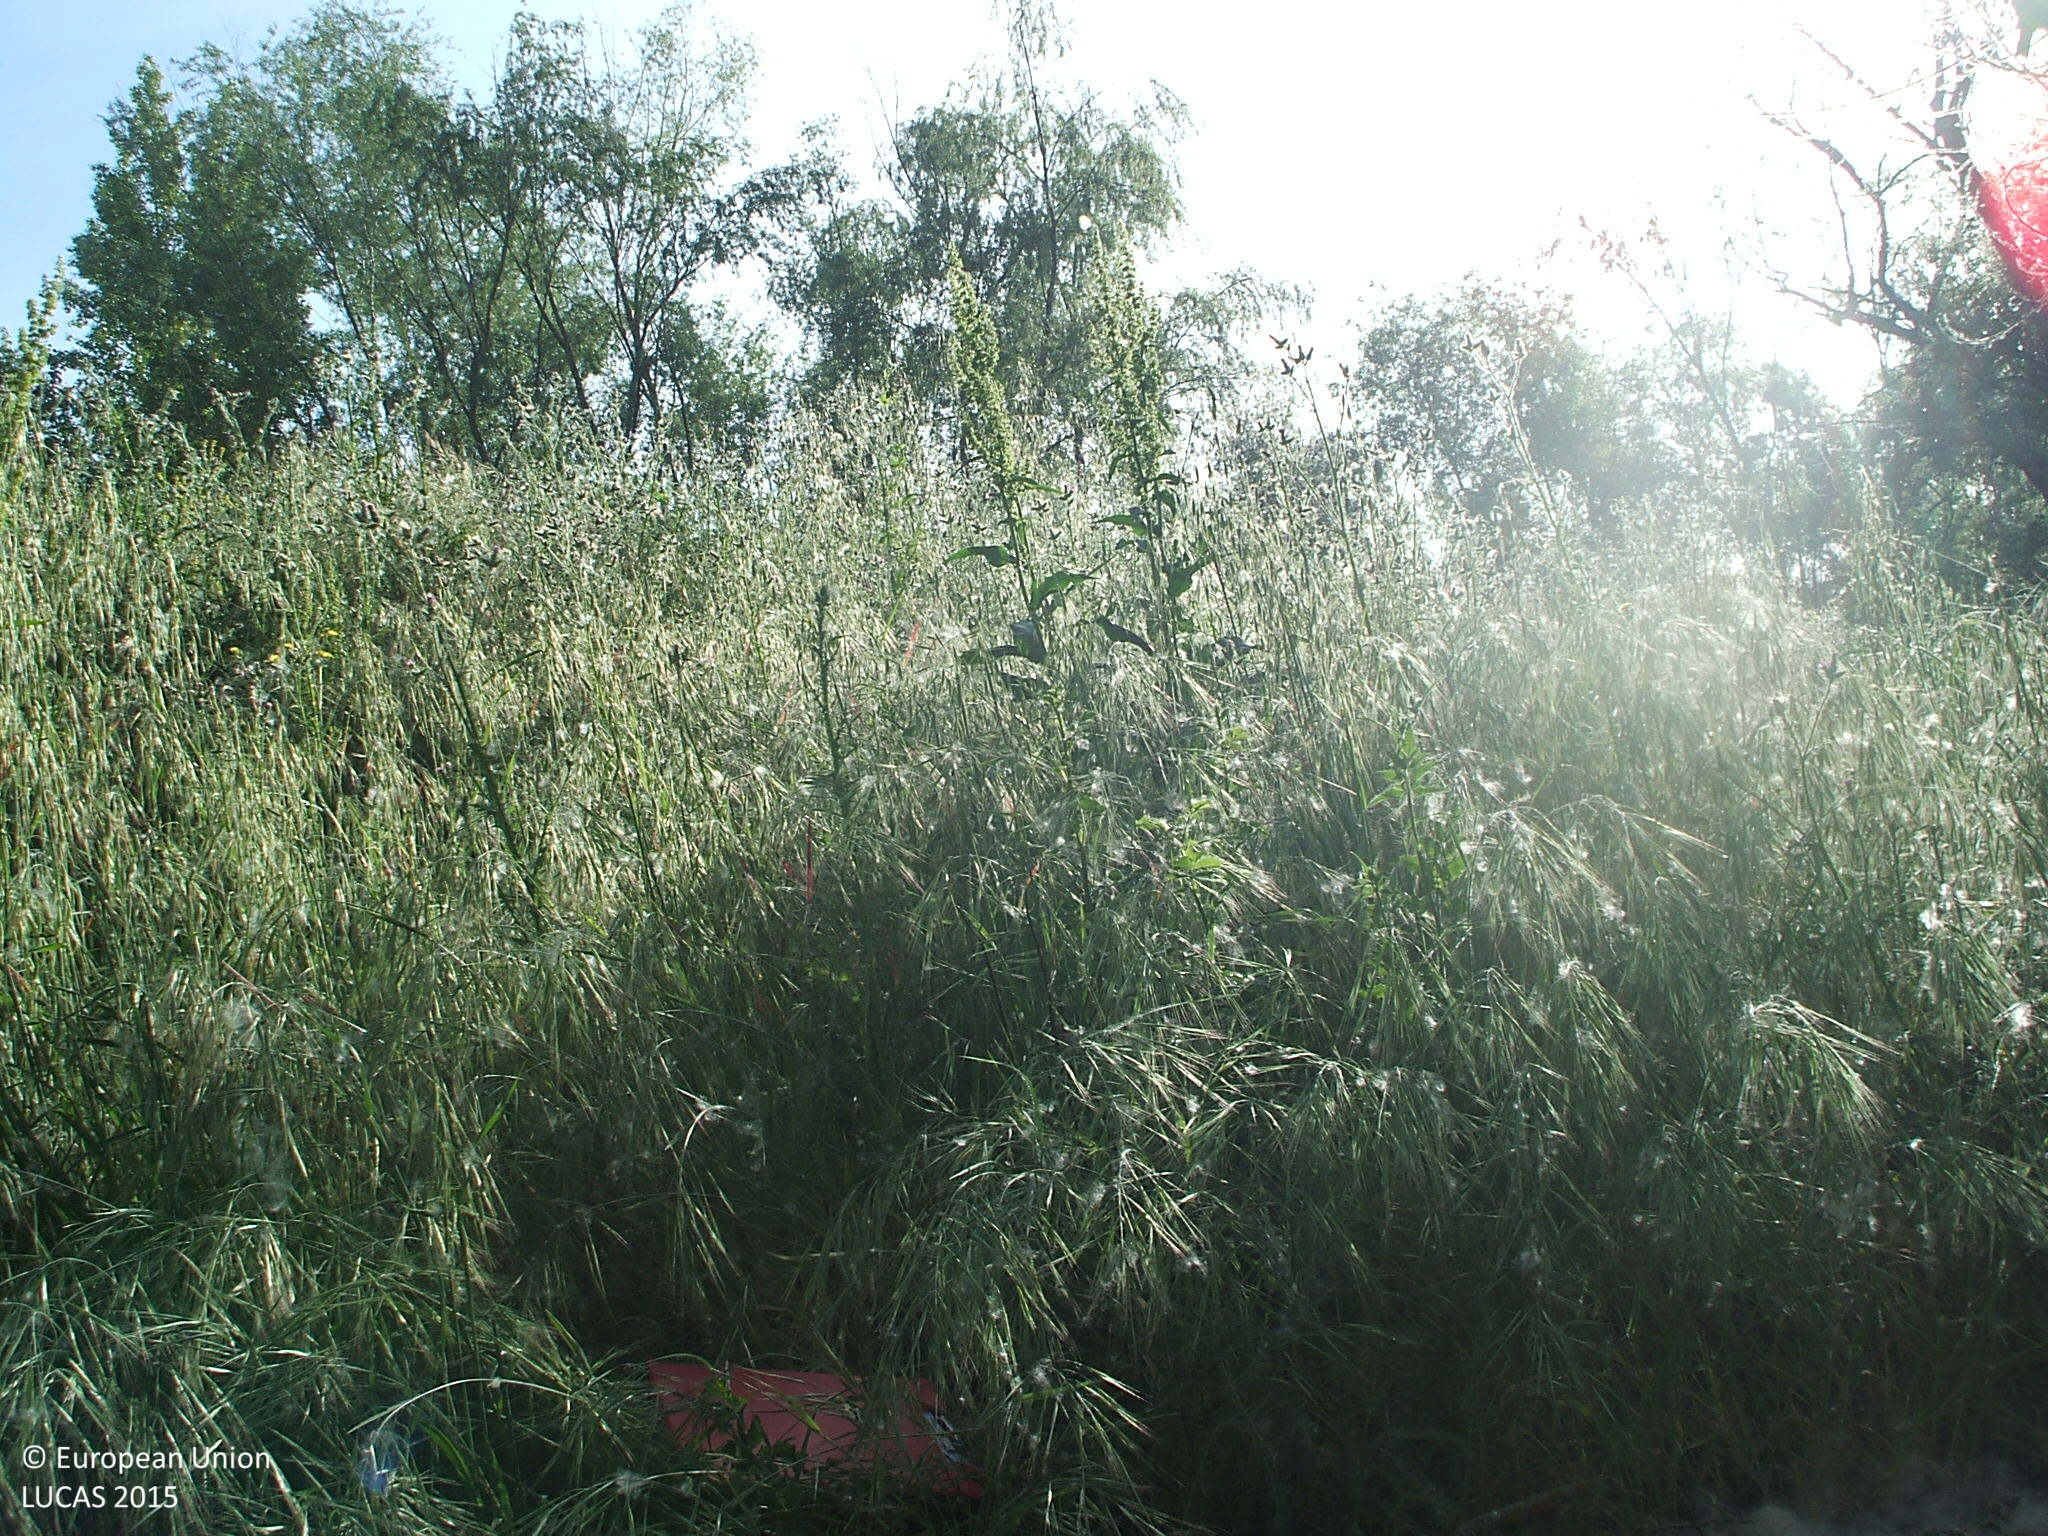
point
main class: Woodland
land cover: Broadleaved woodland
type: floodplain forest
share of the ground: 50 - 75 %
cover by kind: broadleaved forest trees 70 %, herbaceous plants 30 %
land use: Semi-natural and natural areas not in use
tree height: > 5 m
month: May
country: ES
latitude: 40.6839
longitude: -3.3714
